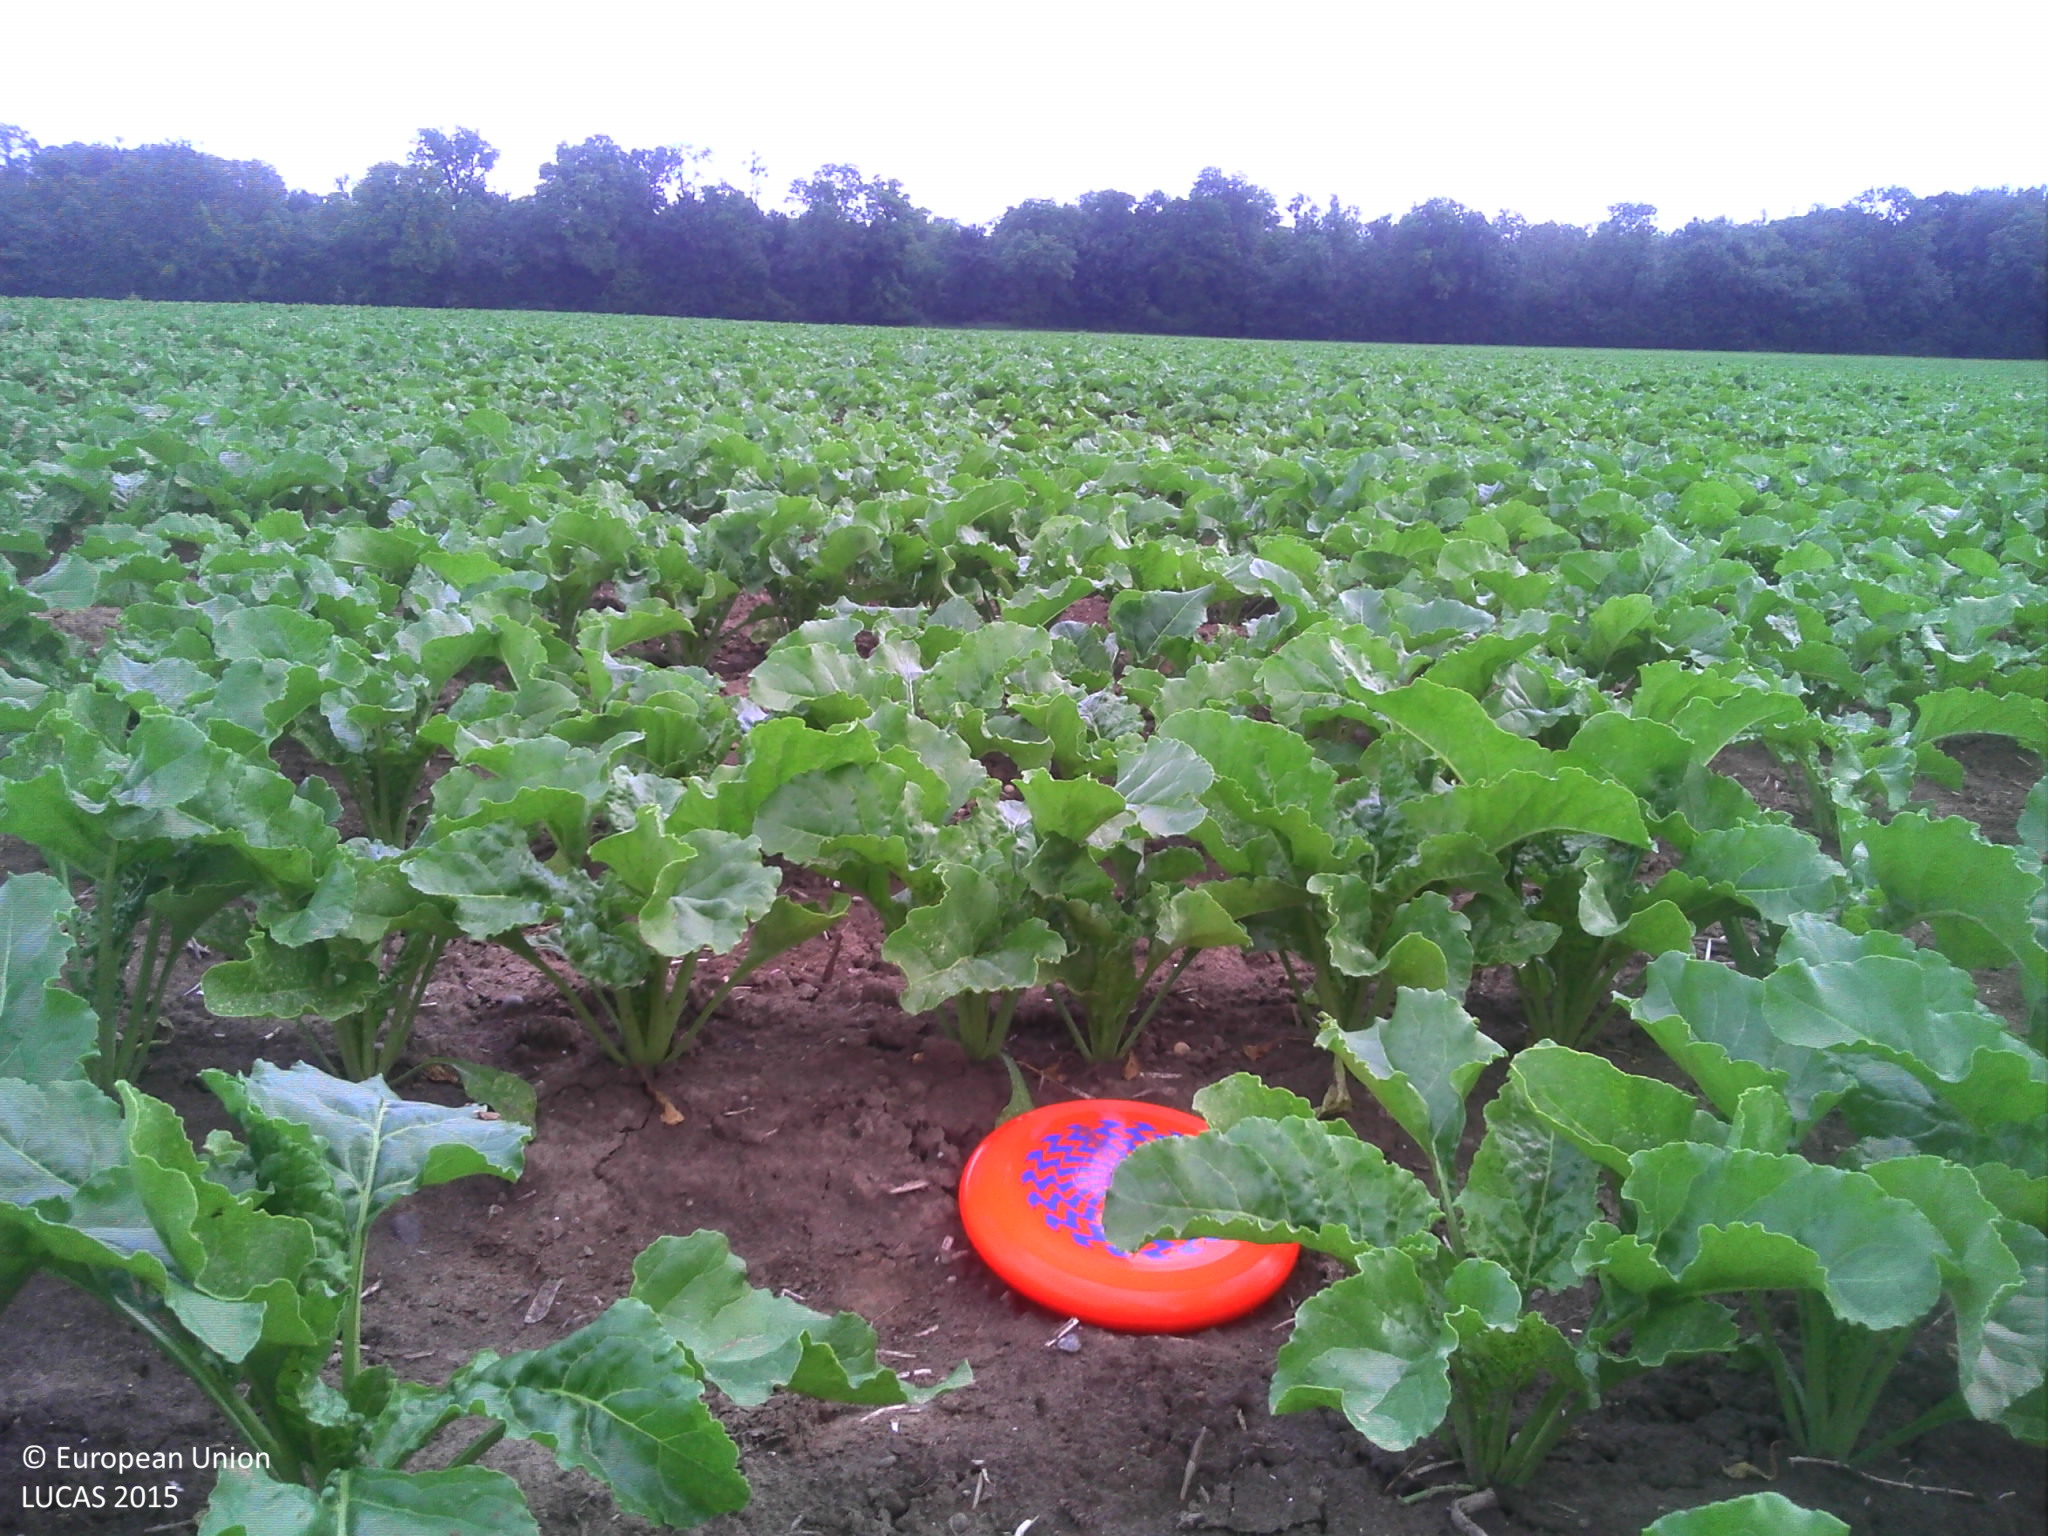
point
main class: Cropland
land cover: Sugar beet
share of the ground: > 75 %
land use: Agriculture (excluding fallow land and kitchen gardens)
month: May
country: FR
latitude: 48.1973
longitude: 7.5928
